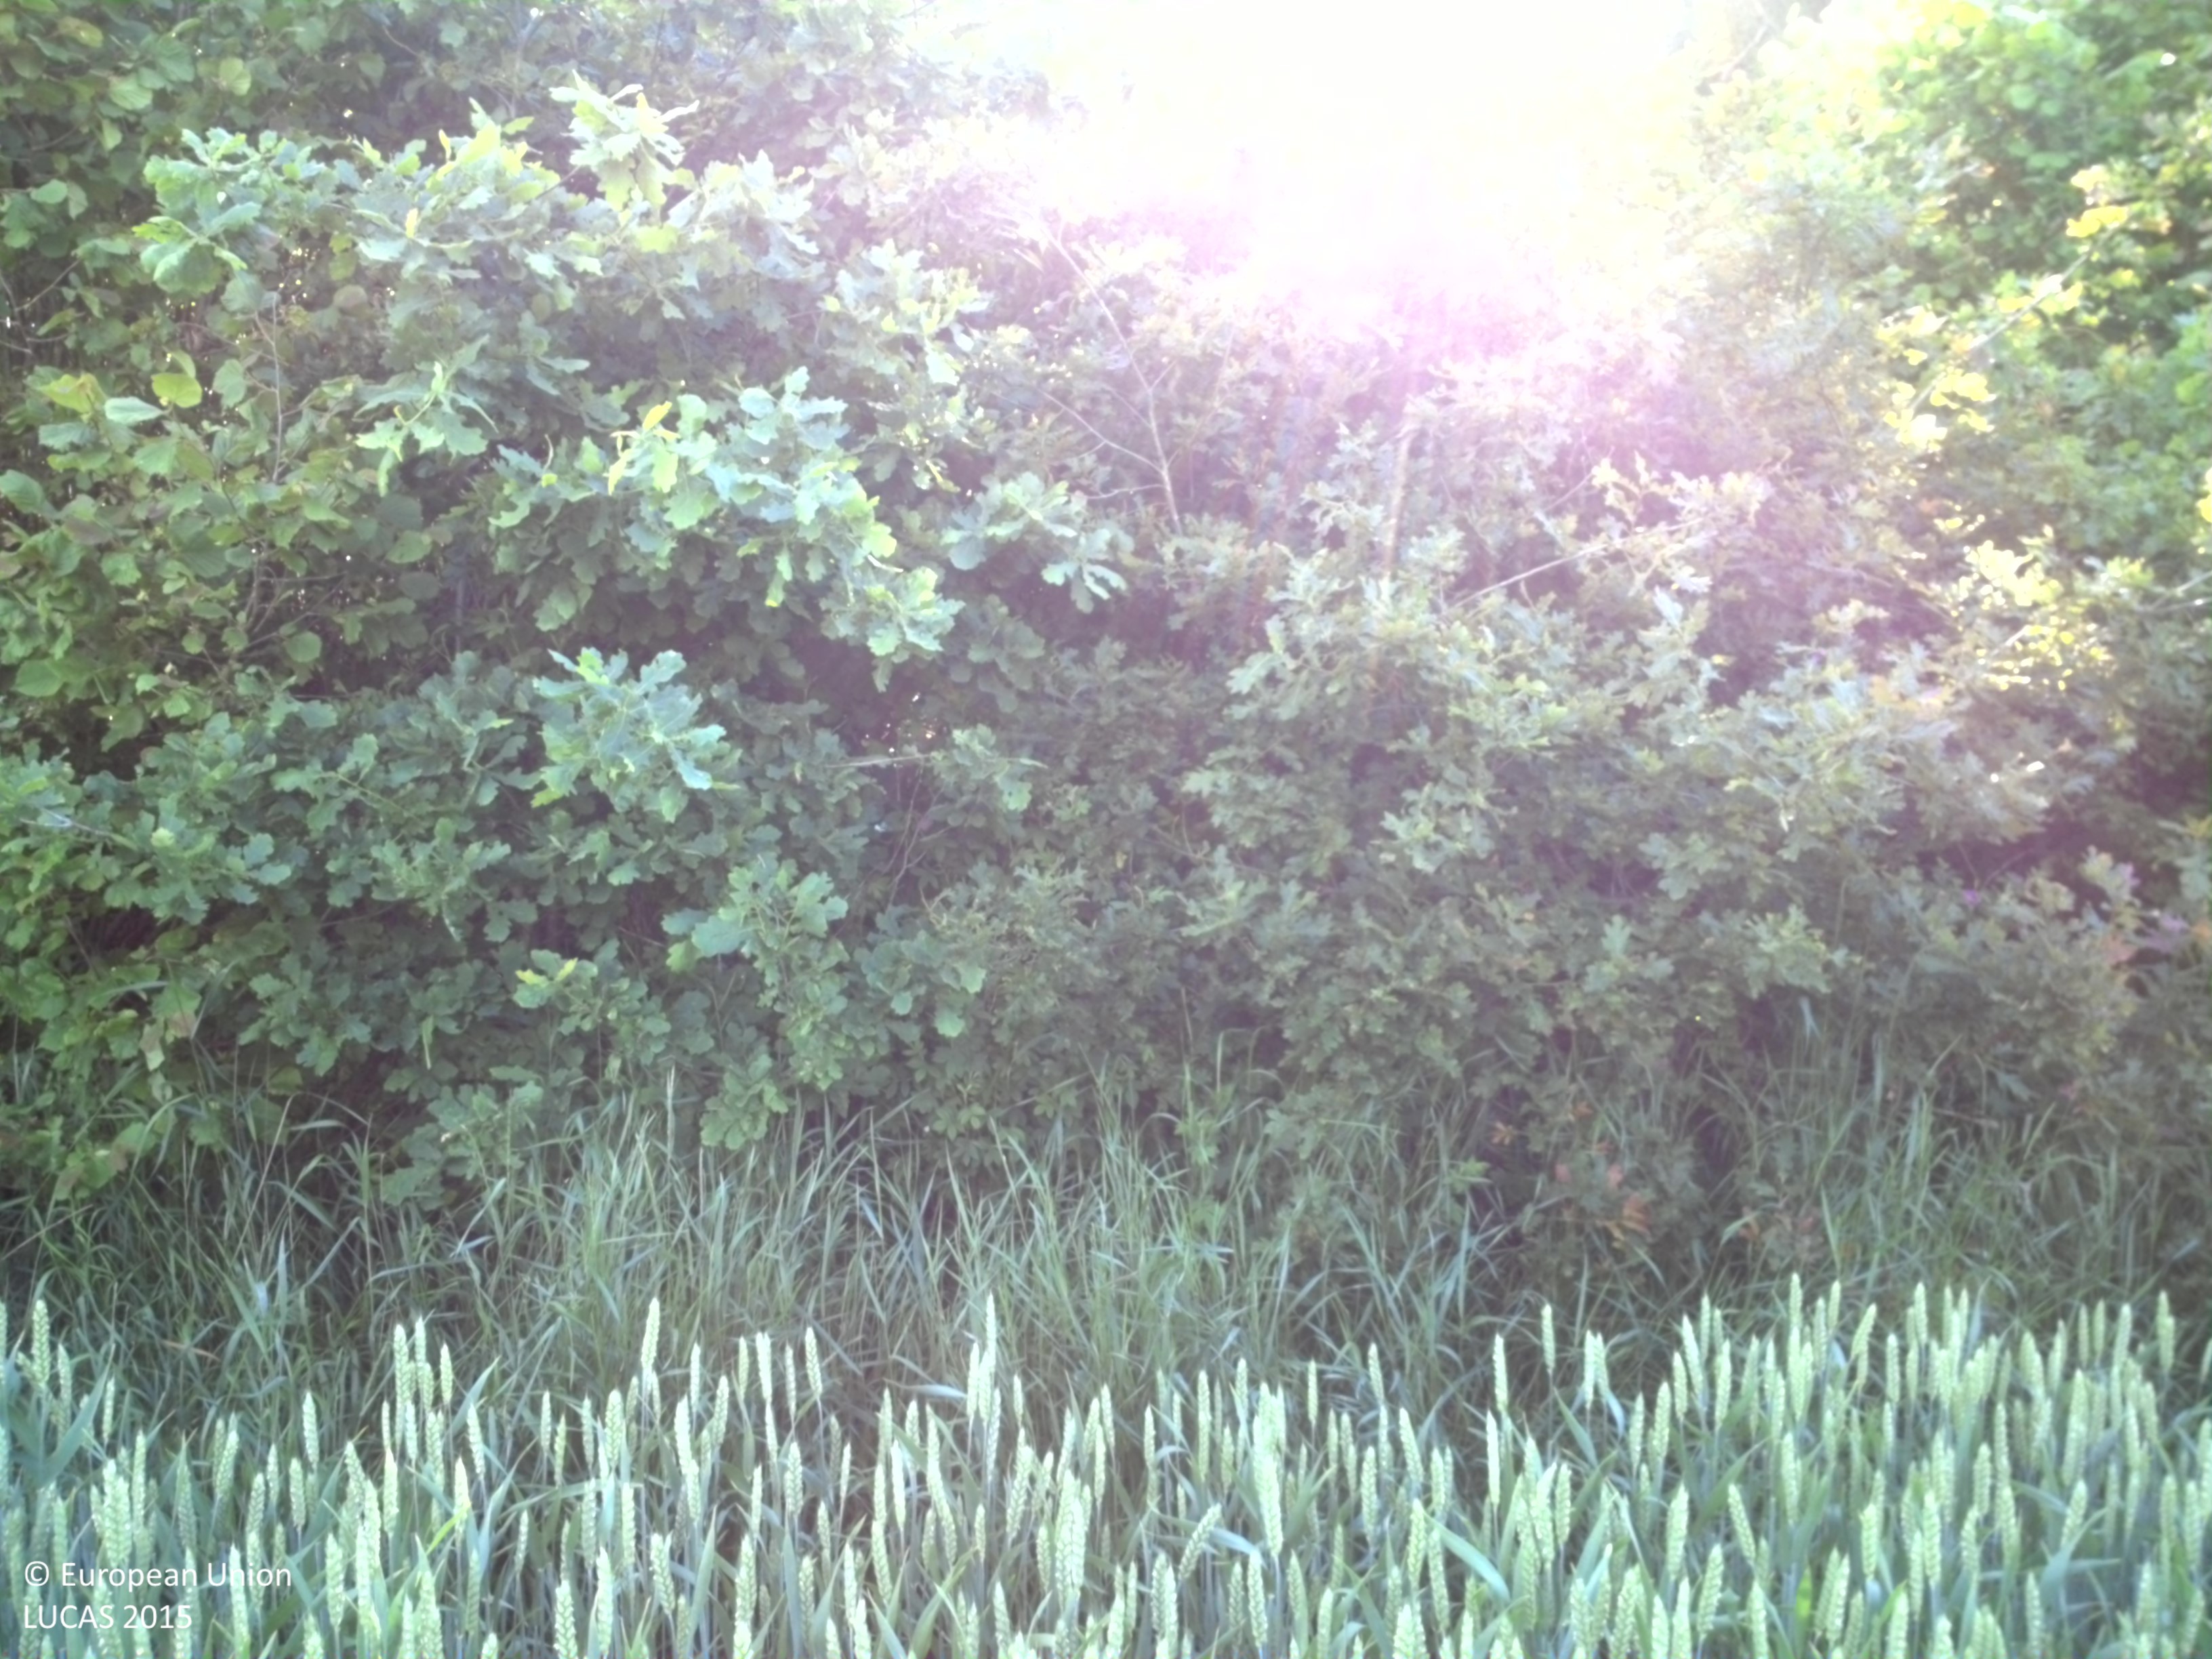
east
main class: Artificial land
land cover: Other artificial areas
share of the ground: > 75 %
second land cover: Common wheat
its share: > 75 %
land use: Electricity, gas and thermal power distribution
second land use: Agriculture (excluding fallow land and kitchen gardens)
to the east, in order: Artificial constructions in urban areas; Common wheat; Broadleaved woodland; Common wheat; Grass margins; Paved roads, cycling and walking lanes; Grass margins; Ditches and canals; Grassland with sparse tree/shrub cover; Broadleaved woodland
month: June
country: SE
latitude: 58.5230
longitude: 15.4714
